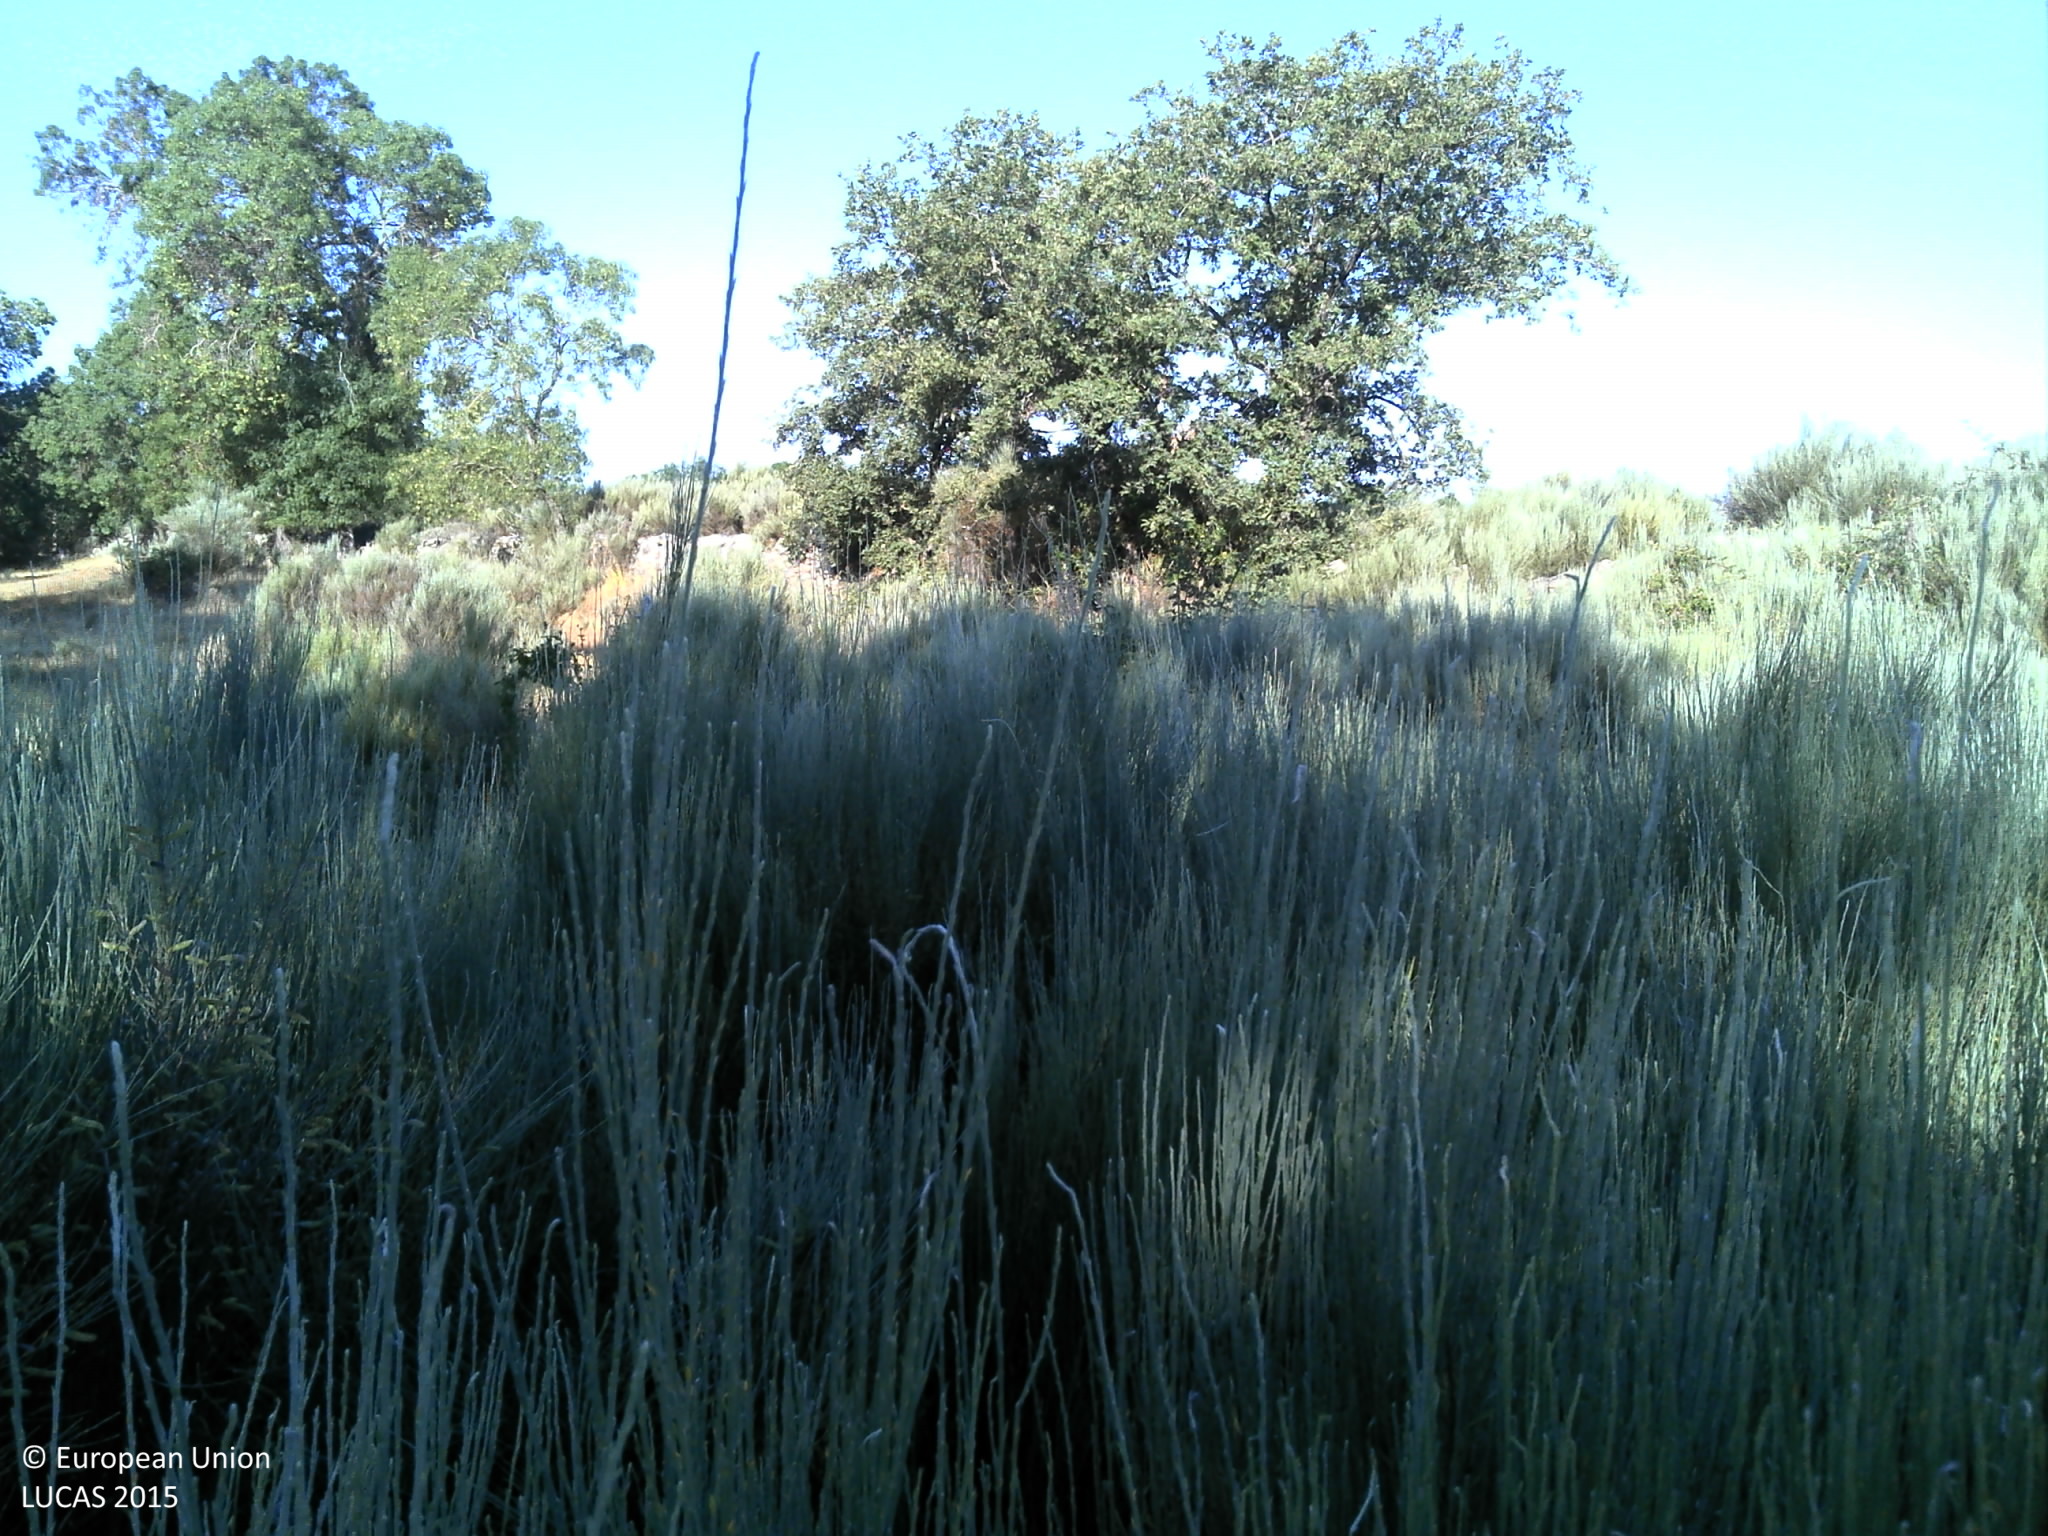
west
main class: Shrubland
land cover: Shrubland with sparse tree cover
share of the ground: > 75 %
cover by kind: shrubs 85 %, broadleaved forest trees 5 %, herbaceous plants 5 %, unconsolidated bare surface 5 %
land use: Agriculture (excluding fallow land and kitchen gardens)
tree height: > 5 m
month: June
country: PT
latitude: 40.9043
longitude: -6.9252
